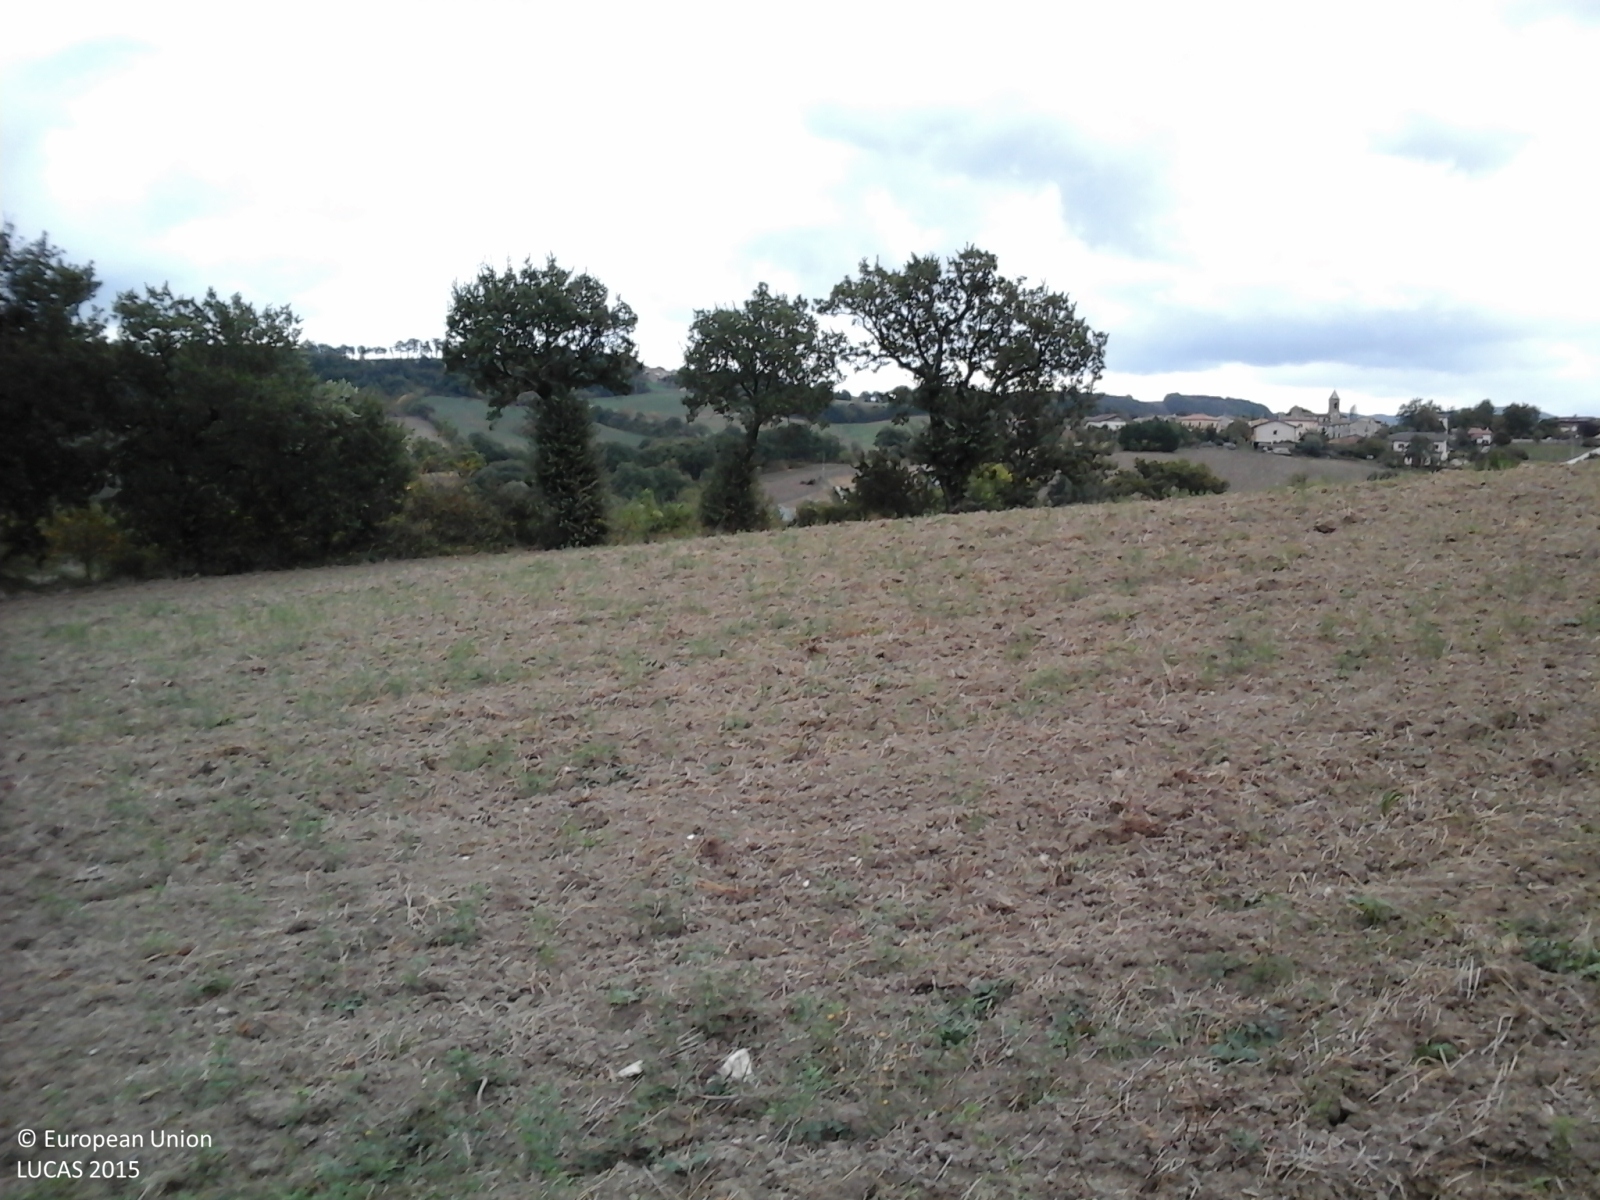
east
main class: Grassland
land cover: Spontaneously vegetated surfaces
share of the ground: < 10 %
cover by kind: unconsolidated bare surface 80 %, herbaceous plants 20 %
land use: Agriculture (excluding fallow land and kitchen gardens)
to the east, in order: Ditches and canals; Spontaneously vegetated surfaces; Electric lines; Spontaneously vegetated surfaces; Abandoned hedges; Nuts trees; Grass margins; Lucerne; Artificial constructions in urban areas; Single bushes/trees; Tomatoes; Other fresh vegetables
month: September
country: IT
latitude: 43.4811
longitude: 12.8487
